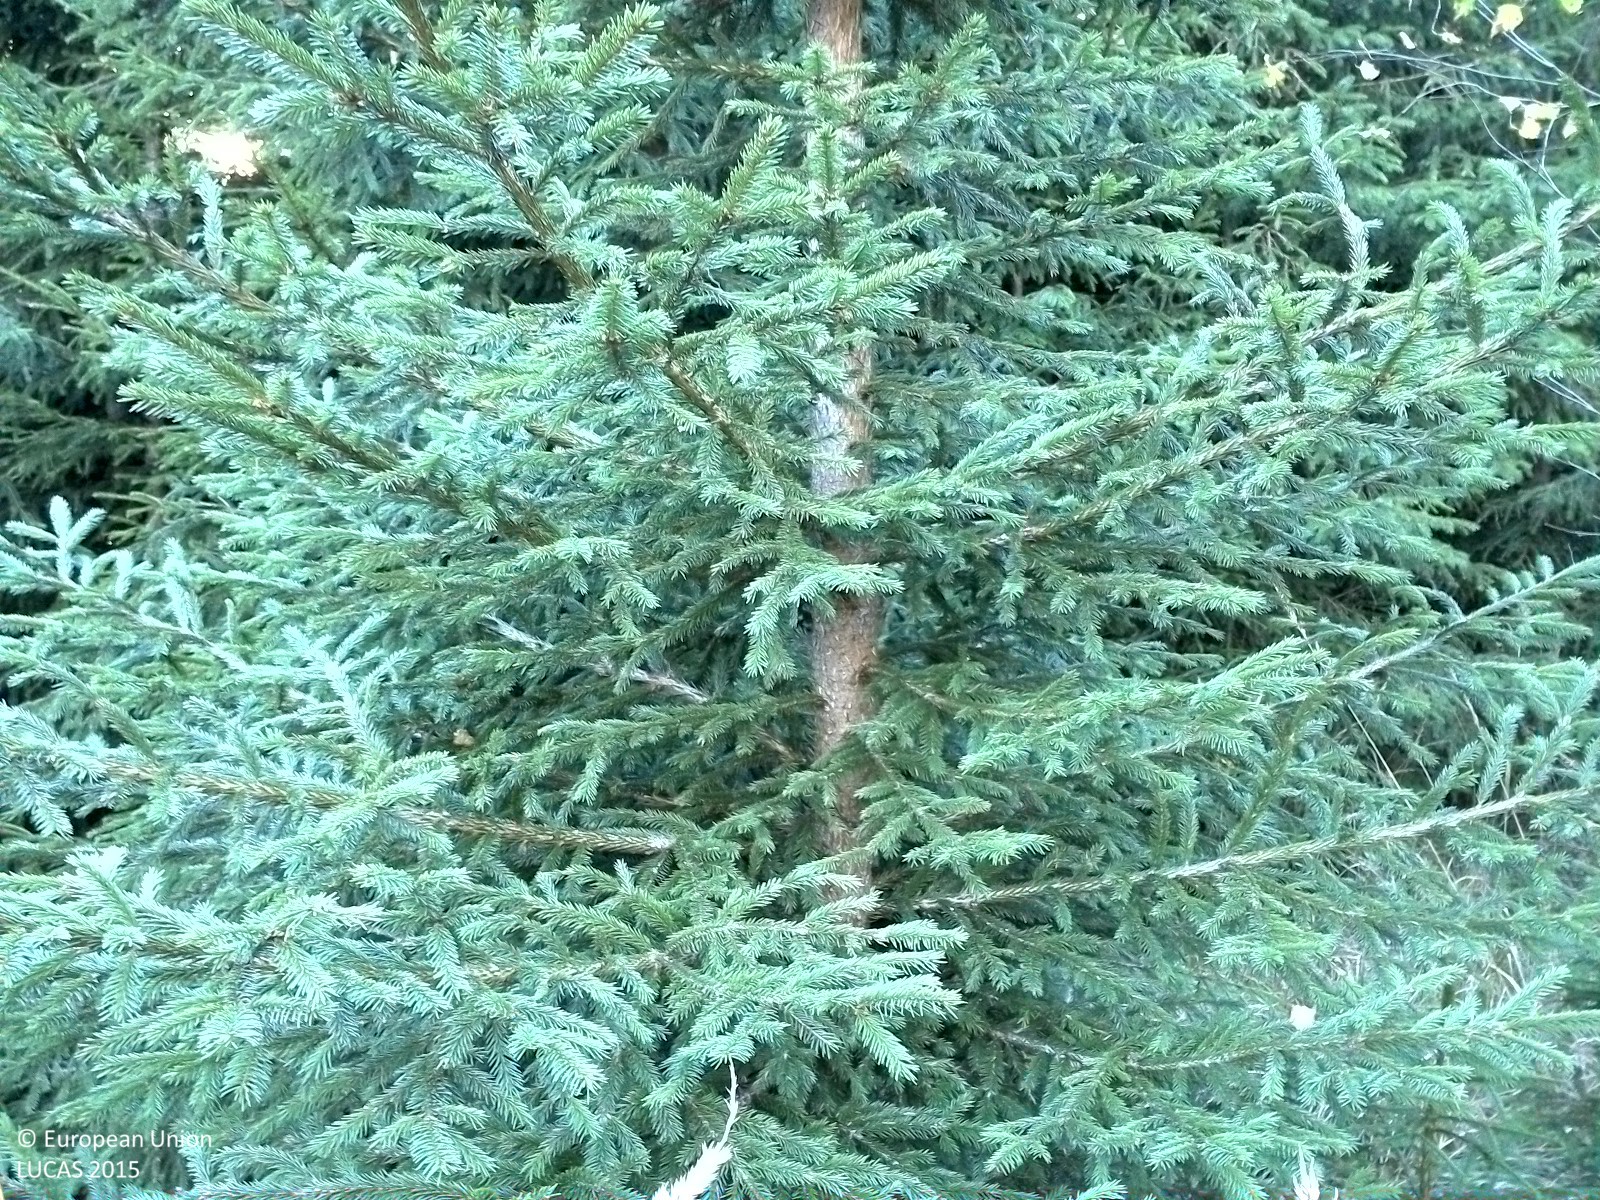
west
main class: Woodland
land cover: Spruce dominated coniferous woodland
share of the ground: 25 - 50 %
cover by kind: herbaceous plants 70 %, coniferous forest trees 25 %, broadleaved forest trees 5 %
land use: Forestry
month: September
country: SE
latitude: 62.6531
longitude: 16.9055
